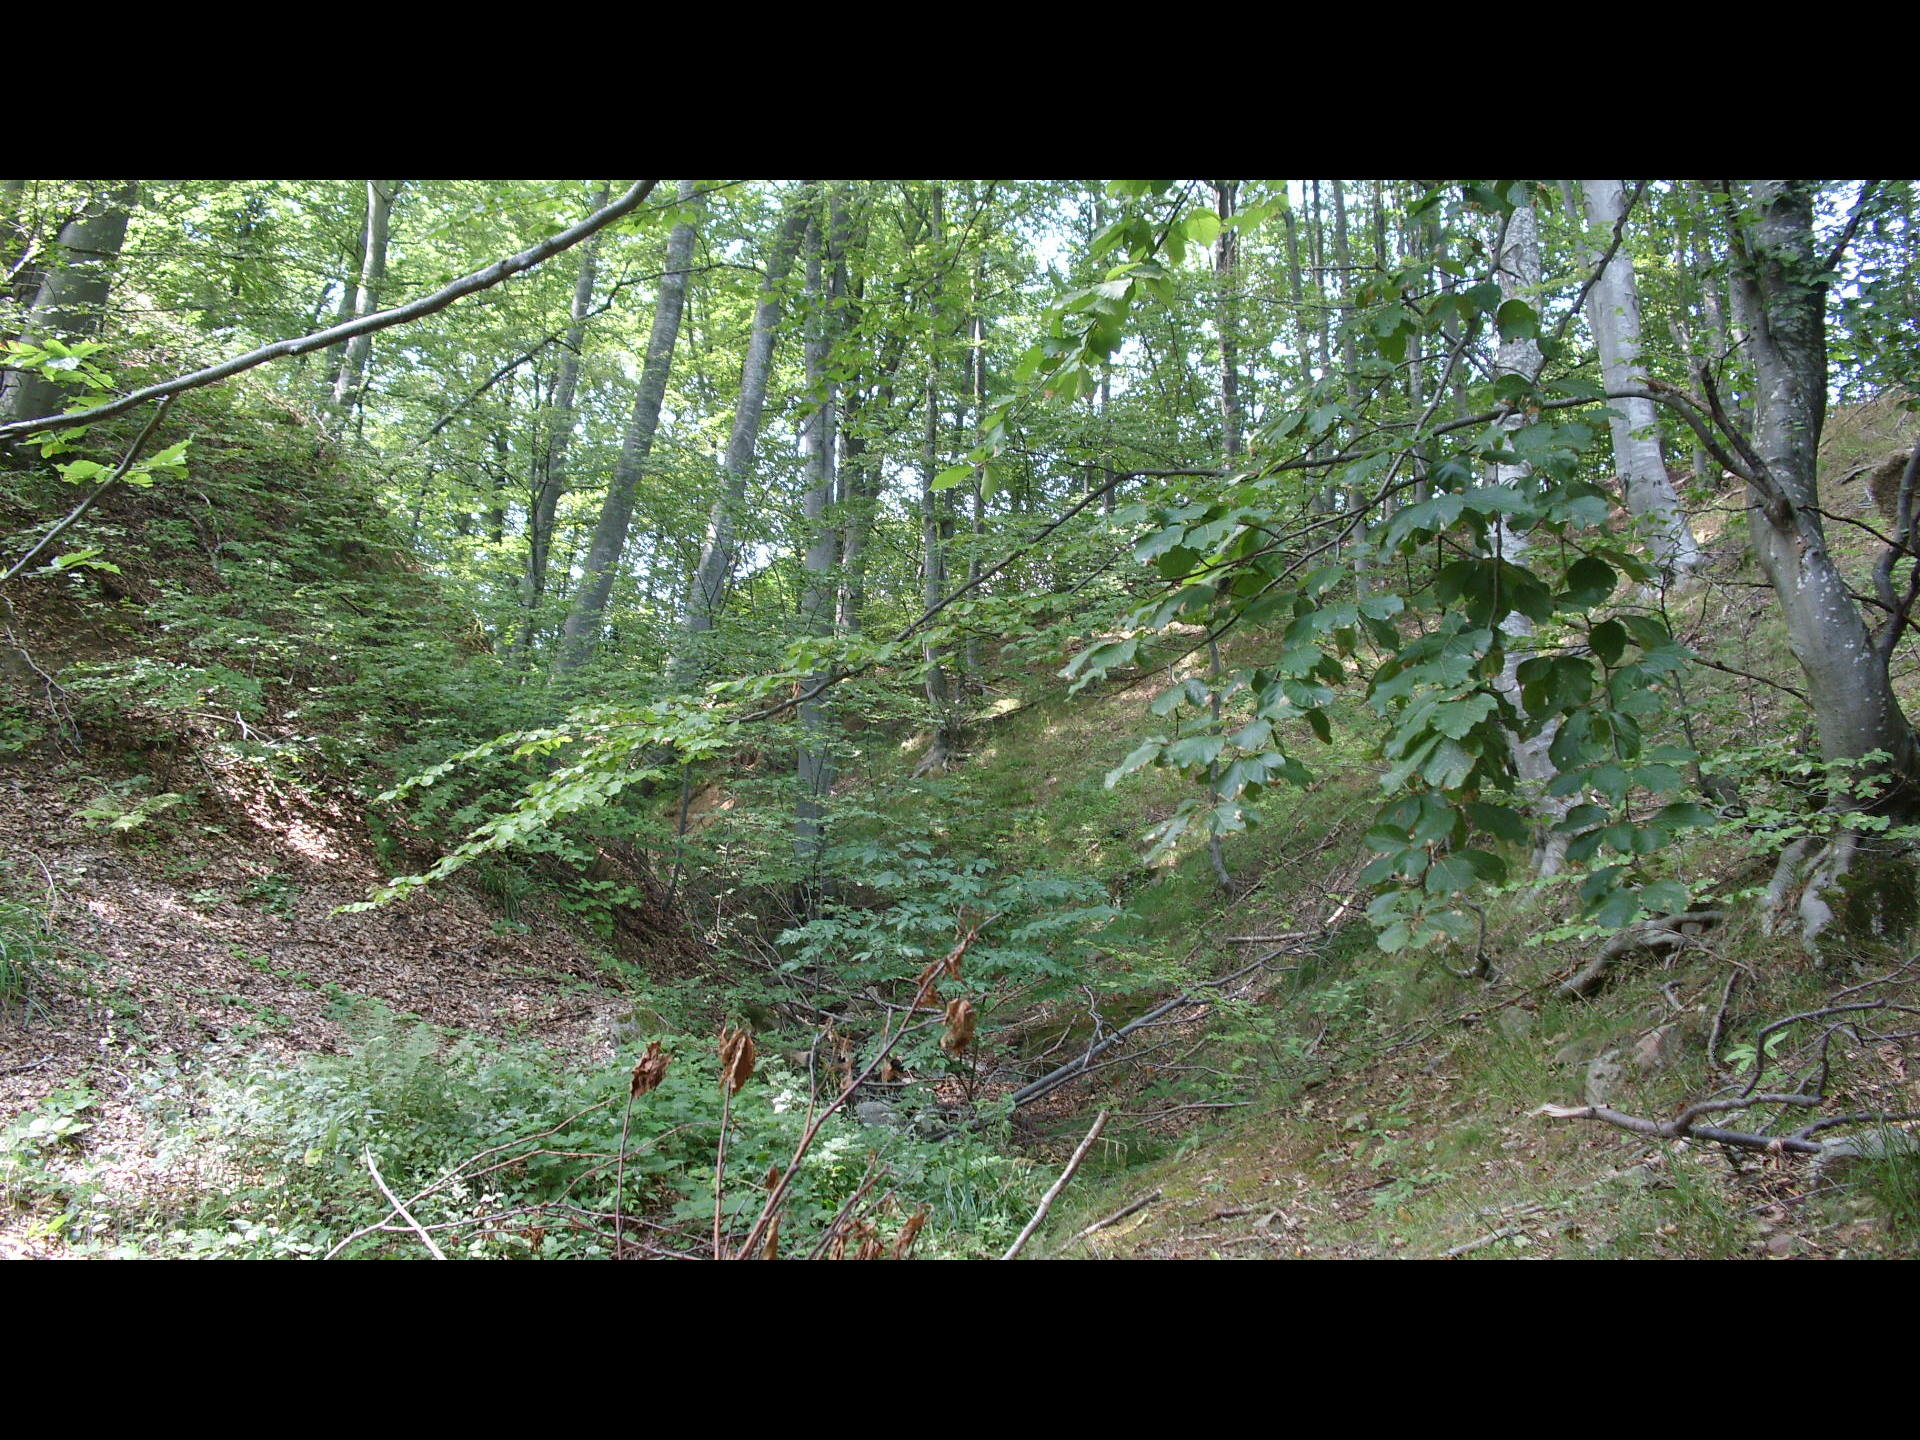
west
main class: Woodland
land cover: Broadleaved woodland
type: beech forest
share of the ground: > 75 %
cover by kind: broadleaved forest trees 90 %, shrubs 5 %, herbaceous plants 5 %
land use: Forestry
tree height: > 5 m
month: August
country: BG
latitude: 43.1520
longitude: 23.2321
